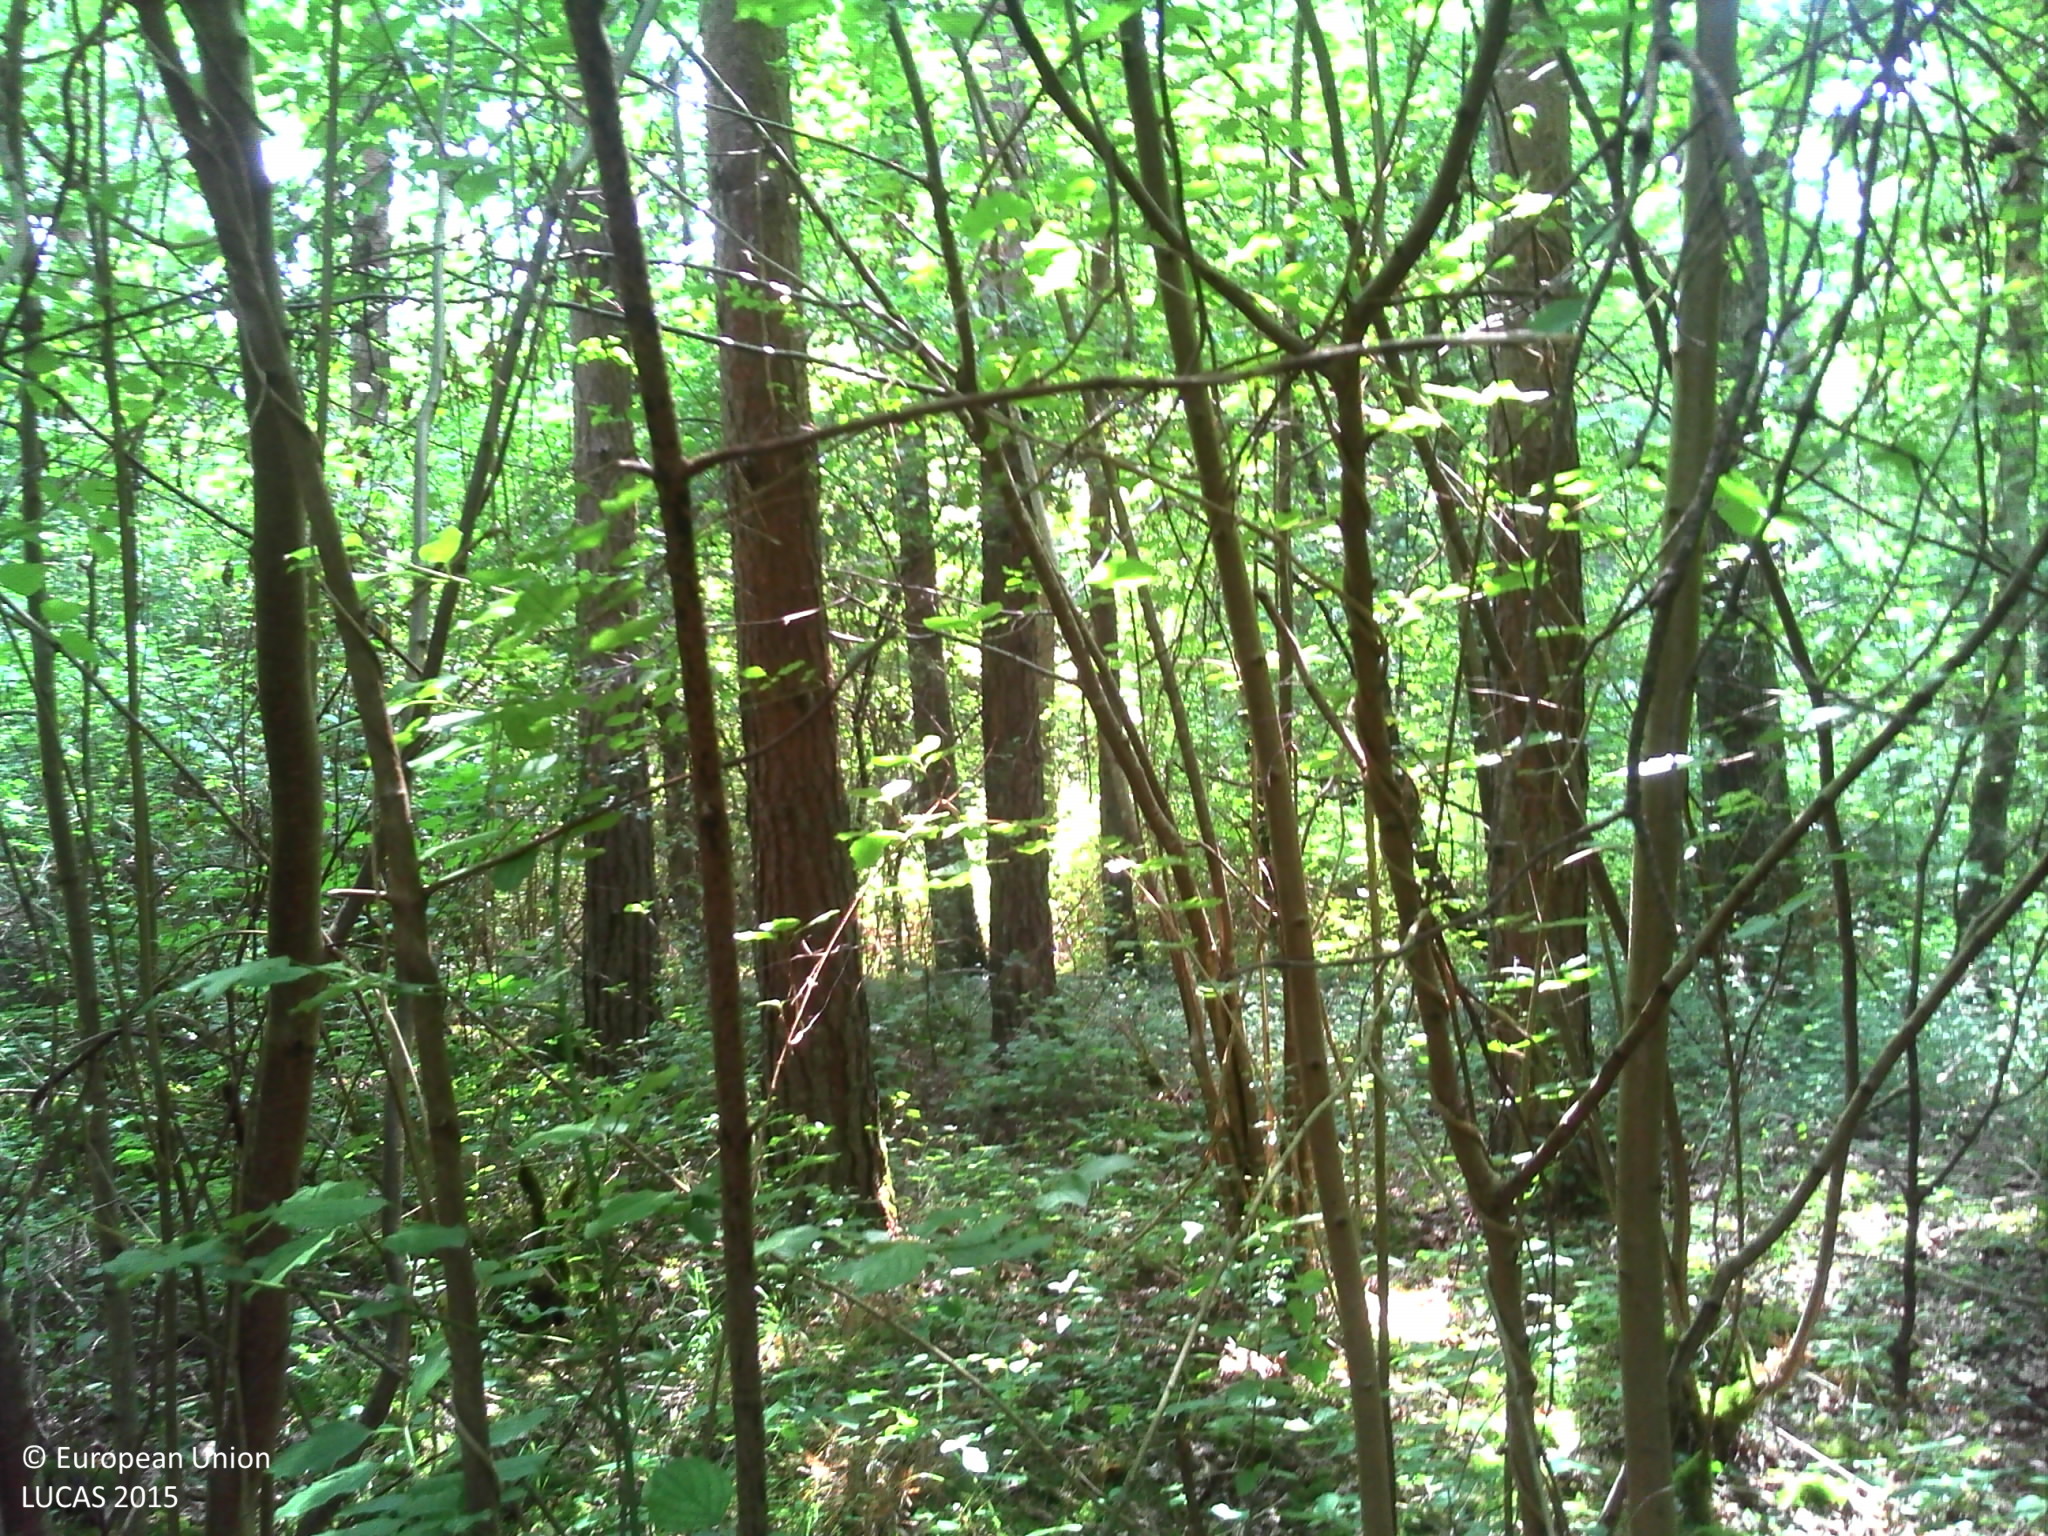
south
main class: Woodland
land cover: Pine dominated mixed woodland
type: hemiboreal forest and nemoral coniferous forest and mixed broadleaved-coniferous forest
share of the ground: > 75 %
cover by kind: coniferous forest trees 50 %, broadleaved forest trees 25 %, herbaceous plants 25 %
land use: Forestry
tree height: > 5 m
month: July
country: FR
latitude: 47.7551
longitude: 2.8294
